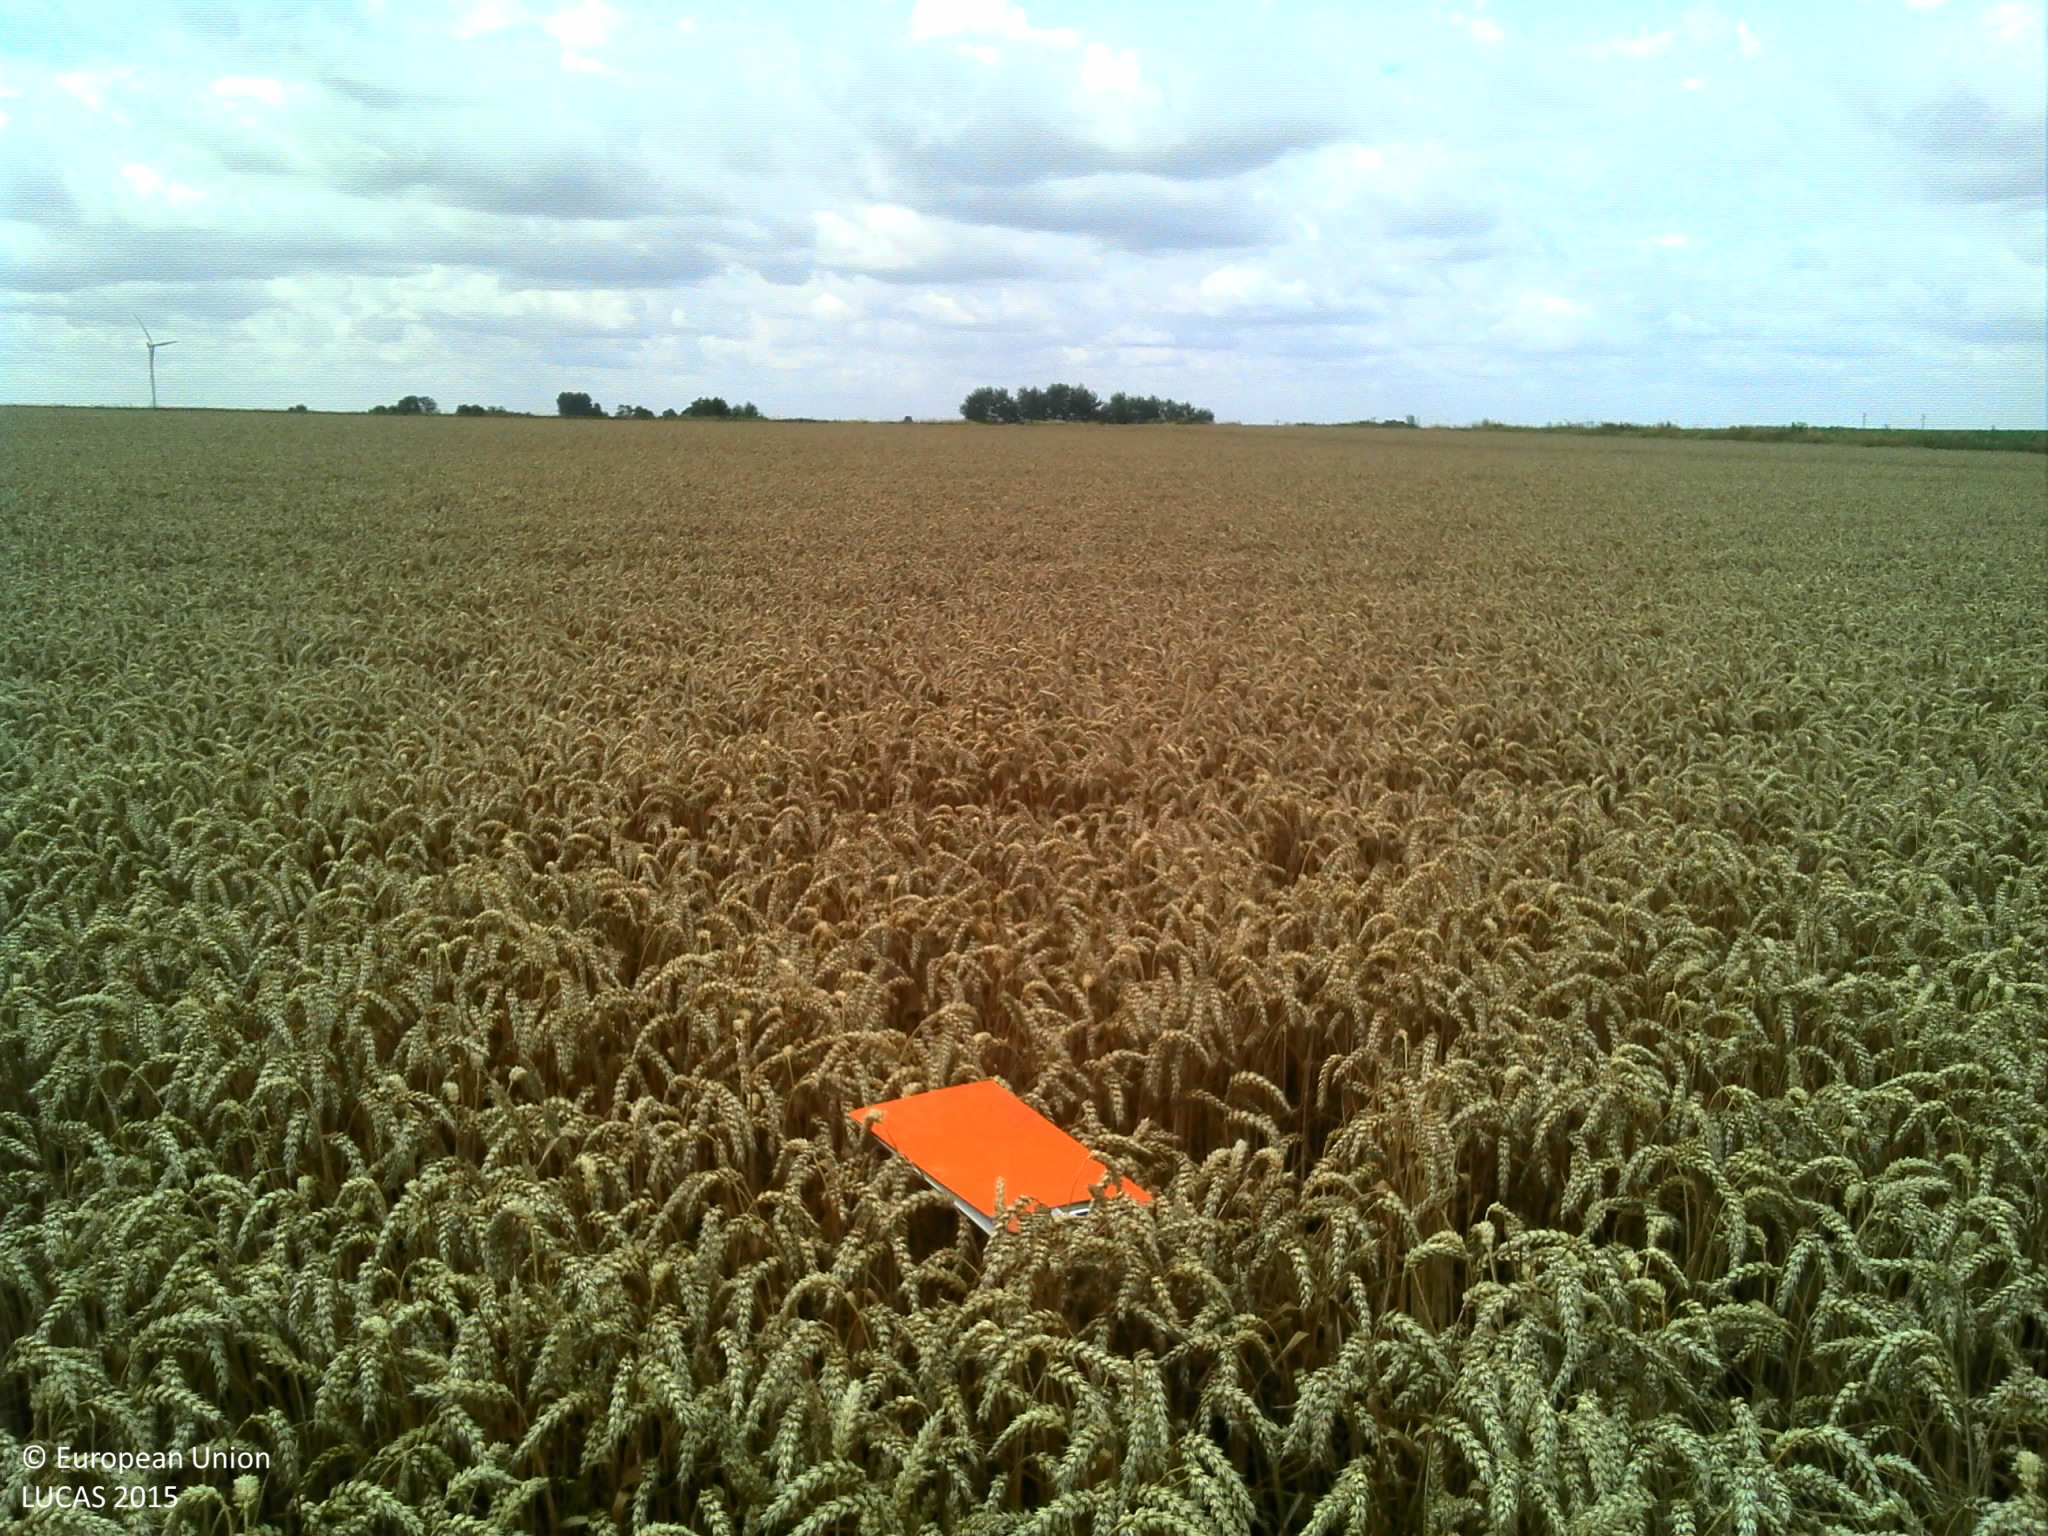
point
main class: Cropland
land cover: Common wheat
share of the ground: > 75 %
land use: Agriculture (excluding fallow land and kitchen gardens)
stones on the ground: < 10 %
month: July
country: FR
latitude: 49.9711
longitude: 3.6492
